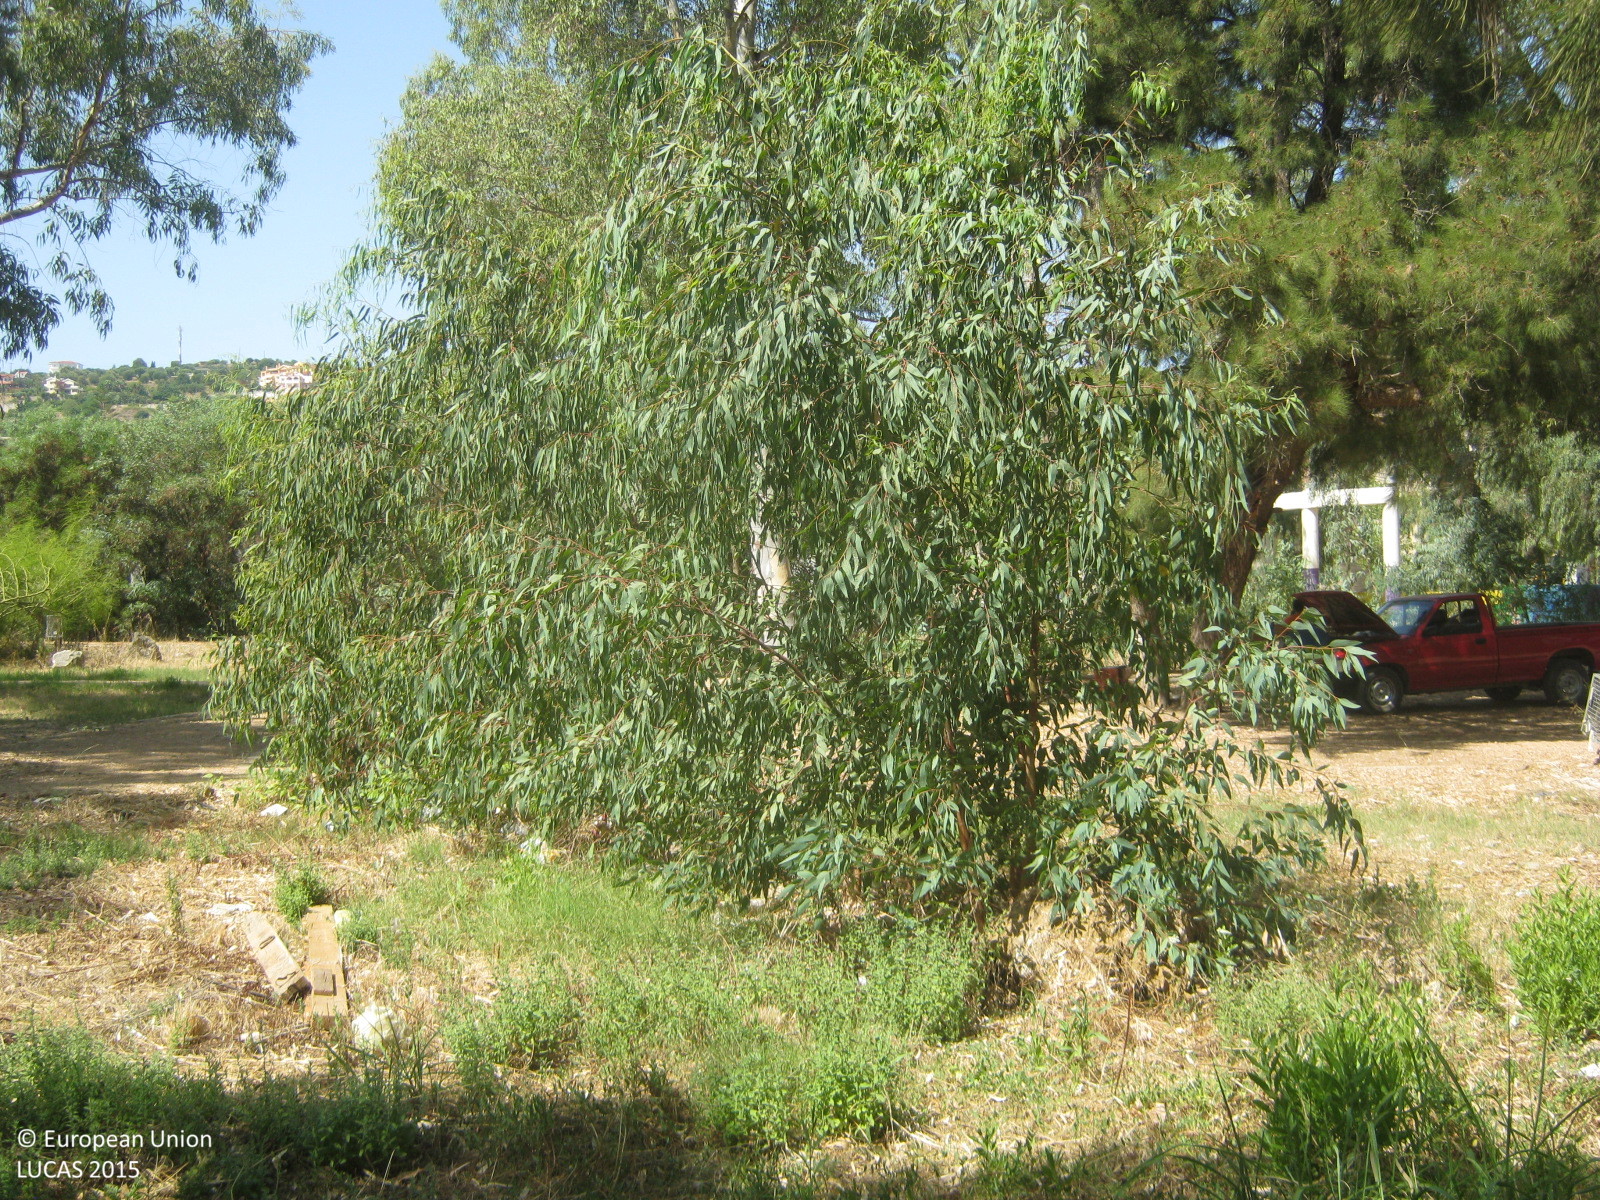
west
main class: Woodland
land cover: Pine dominated coniferous woodland
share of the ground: 50 - 75 %
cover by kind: coniferous forest trees 70 %, herbaceous plants 25 %, shrubs 5 %
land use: Amenities, museums, leisure
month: August
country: GR
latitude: 38.1699
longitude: 20.4962
